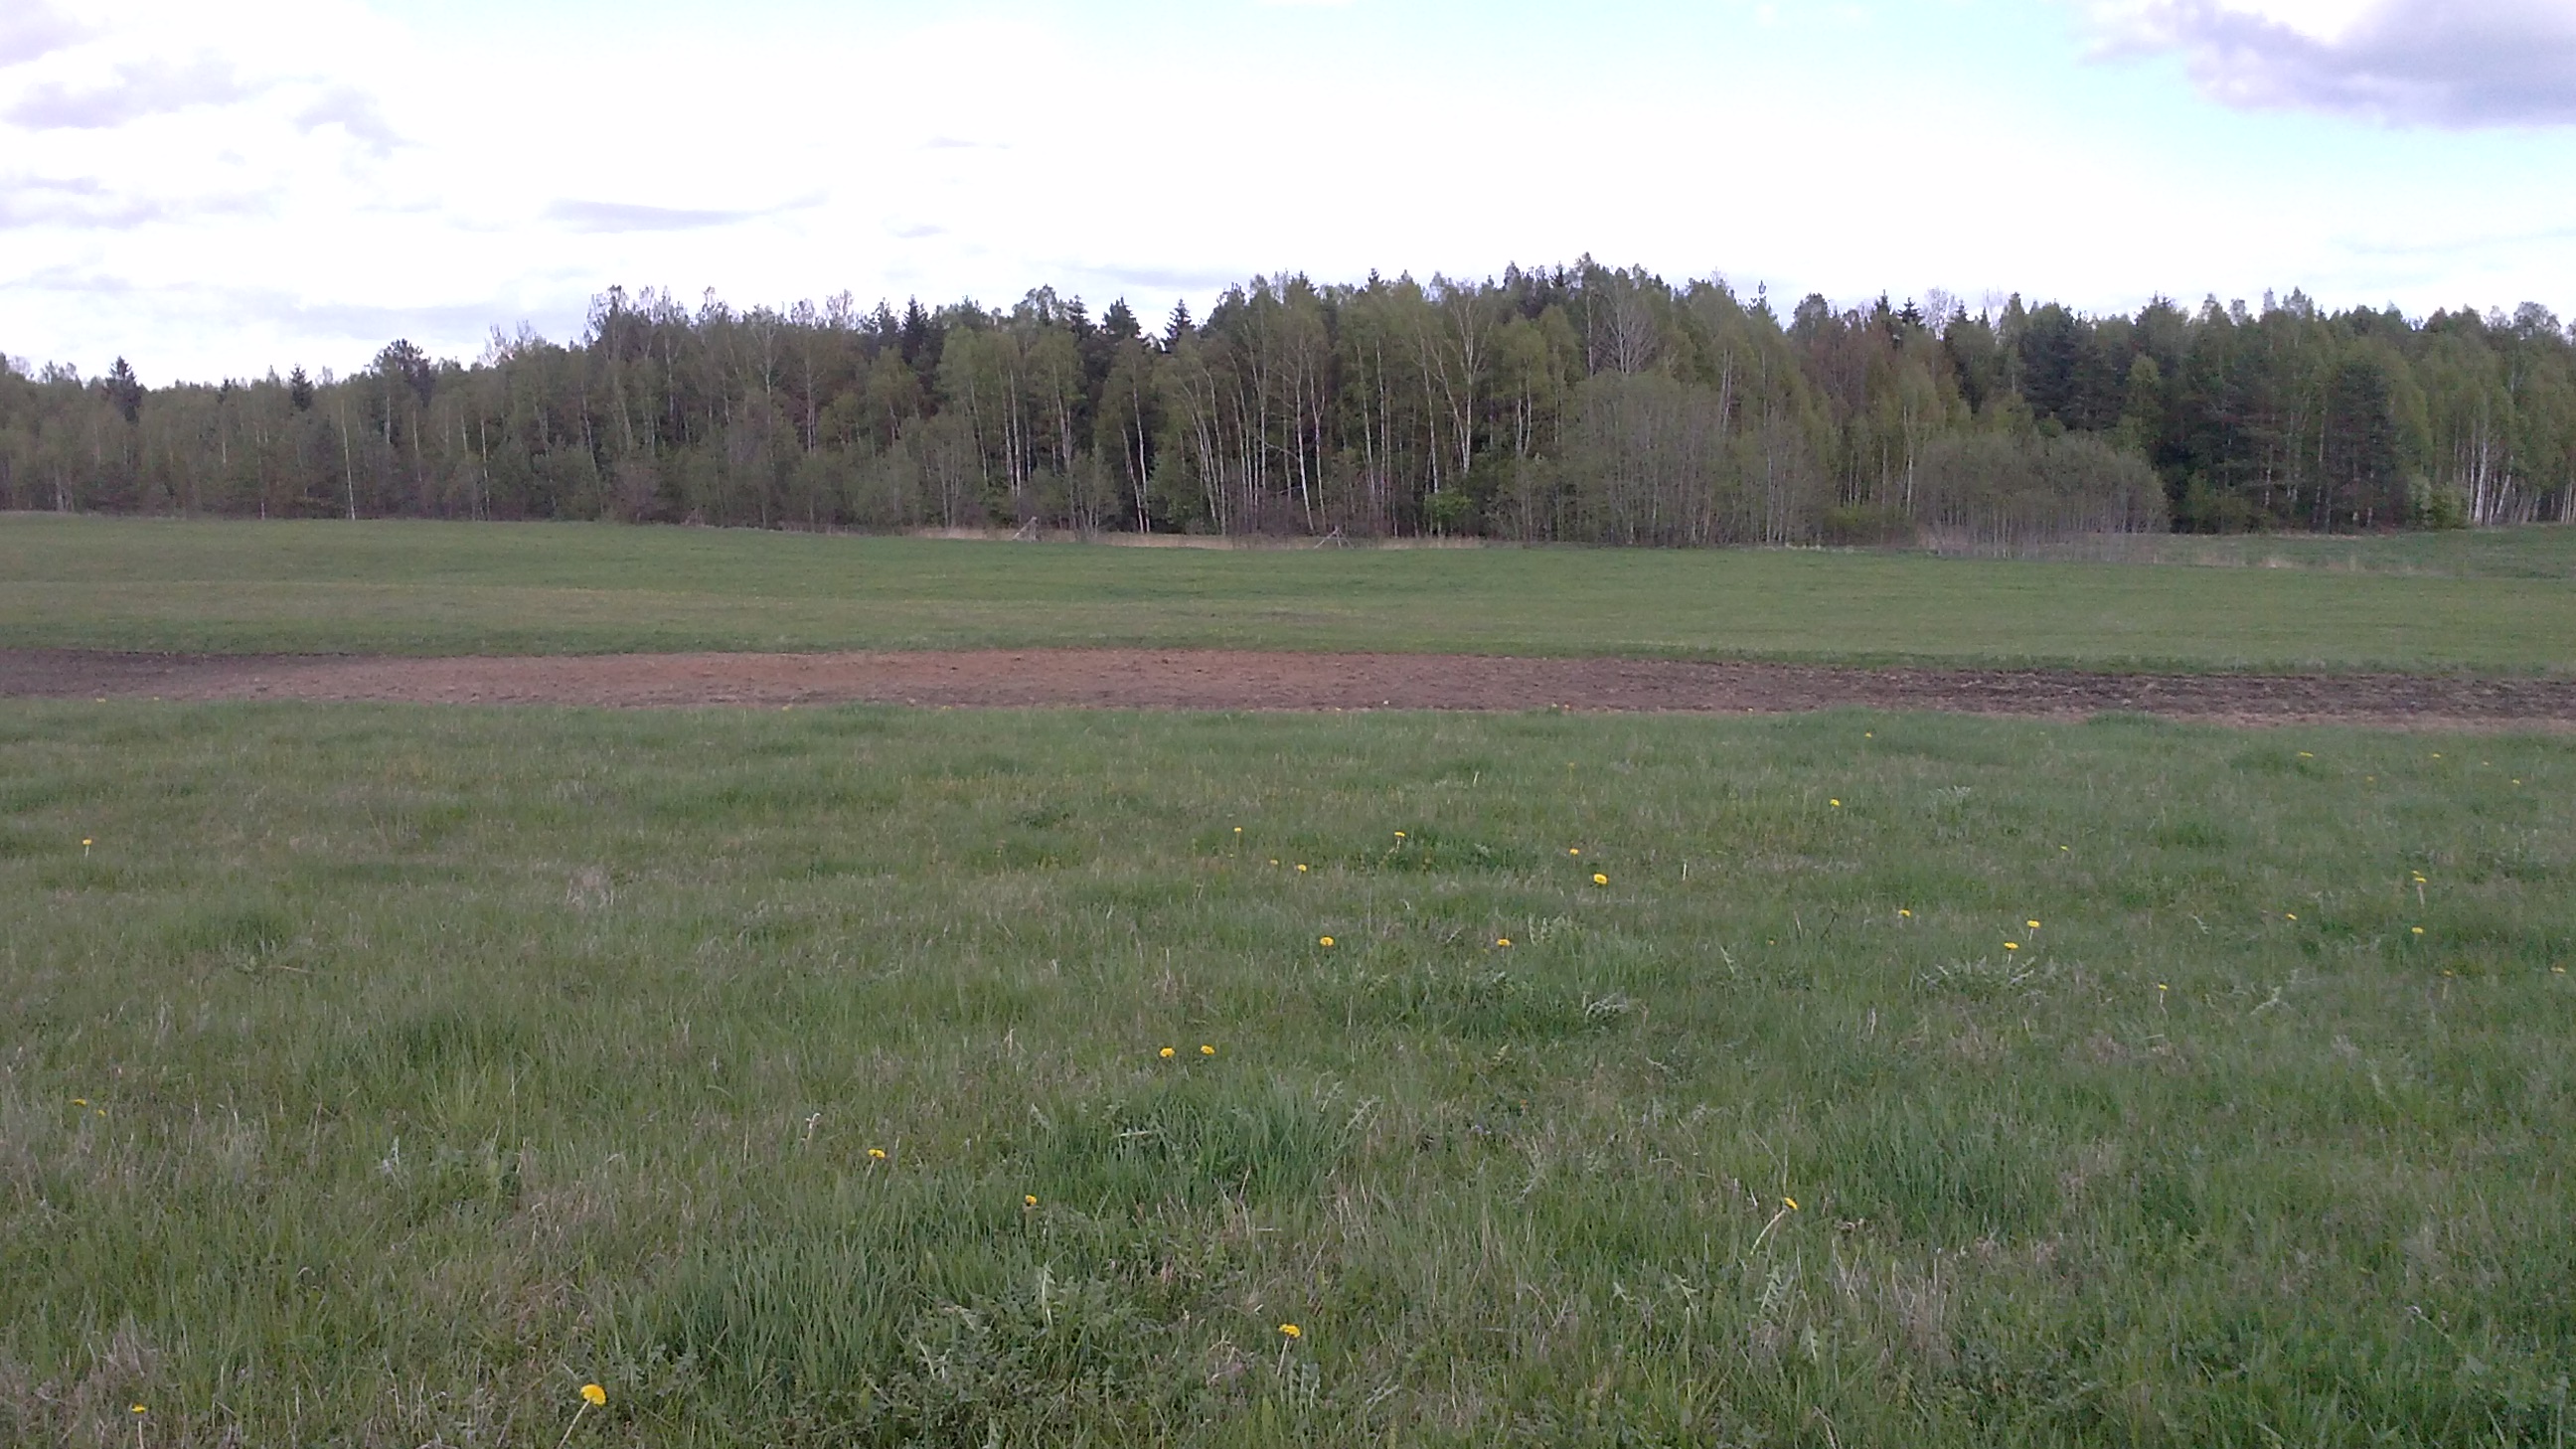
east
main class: Grassland
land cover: Grassland without tree/shrub cover
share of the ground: > 75 %
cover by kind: herbaceous plants 100 %
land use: Agriculture (excluding fallow land and kitchen gardens)
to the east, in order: Grassland without tree/shrub cover; Other bare soil; Oats; Abandoned hedges; Ditches and canals; Shrubland with sparse tree cover; Spruce dominated mixed woodland
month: May
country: LV
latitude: 56.0493
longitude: 27.3059
